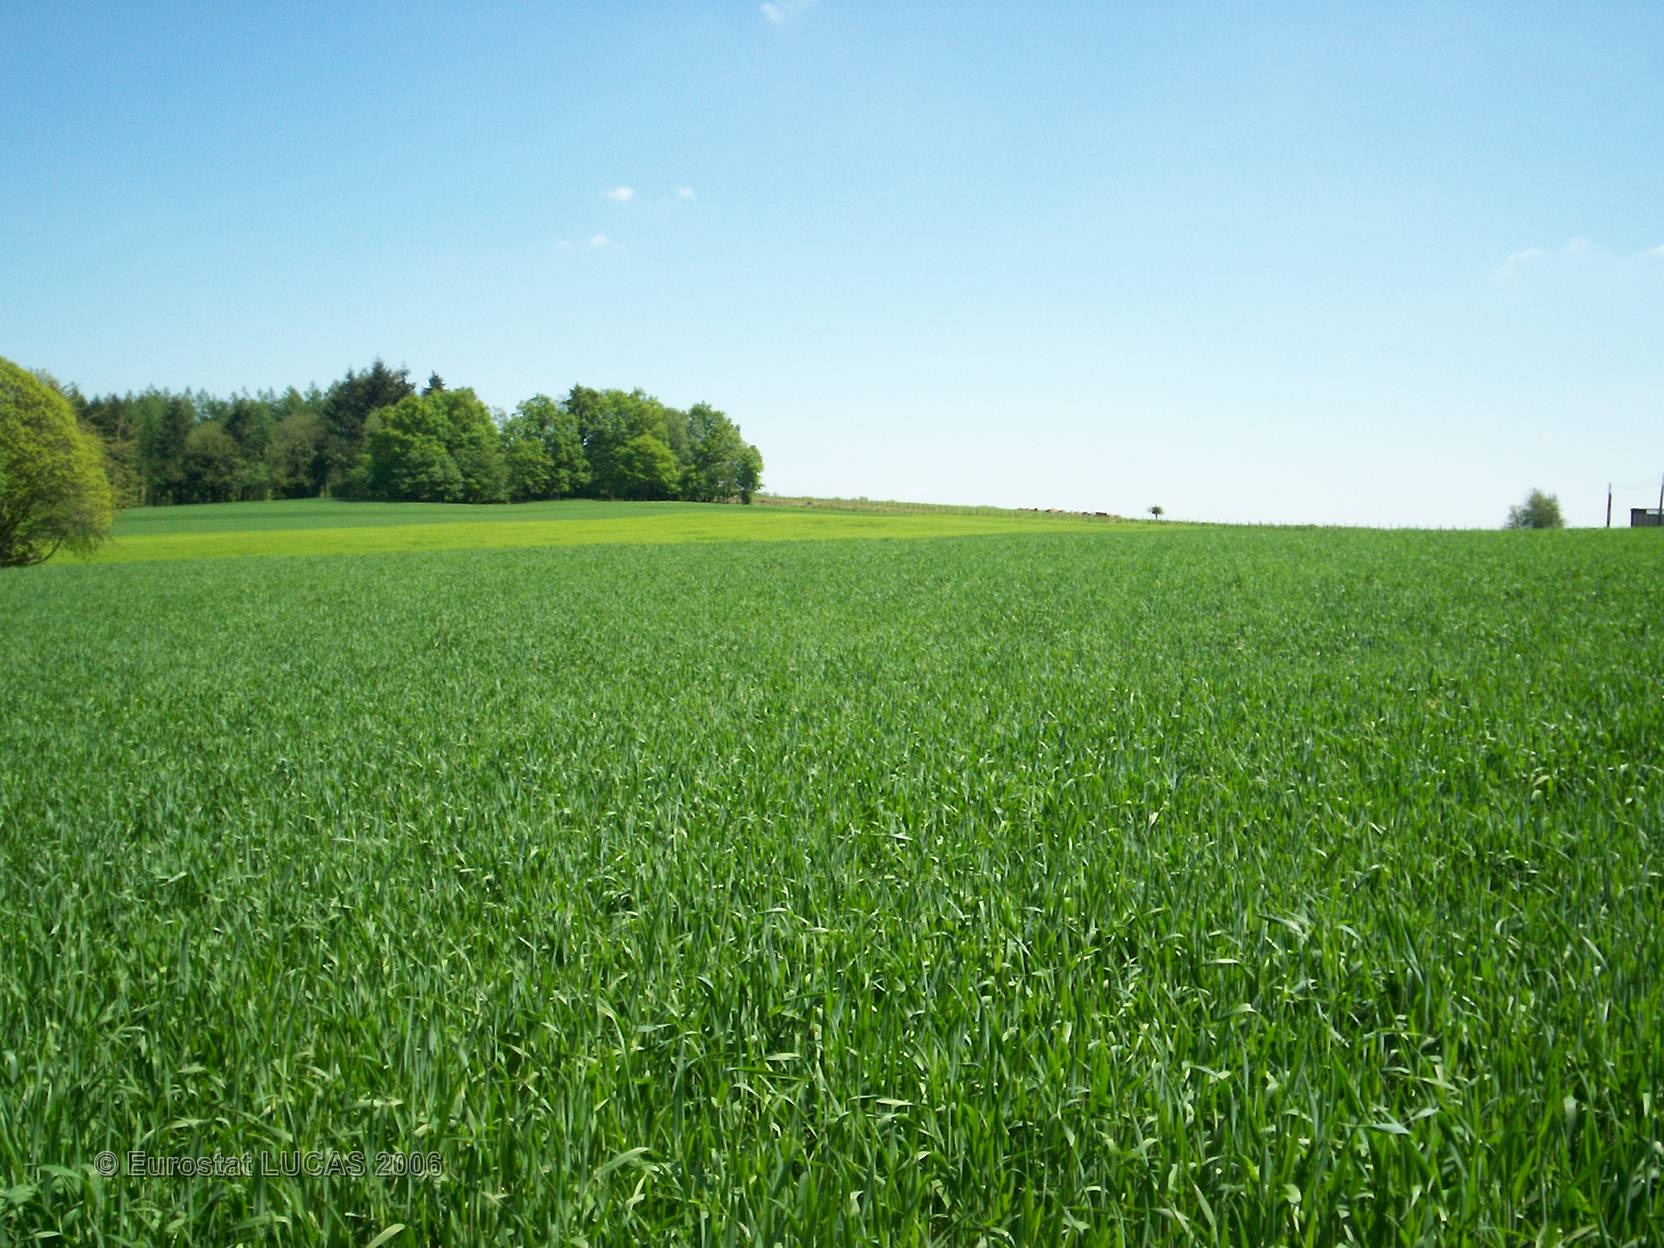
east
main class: Cropland
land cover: Common wheat
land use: Agriculture (excluding fallow land and kitchen gardens)
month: May
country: FR
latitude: 45.8698
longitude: 1.5286
